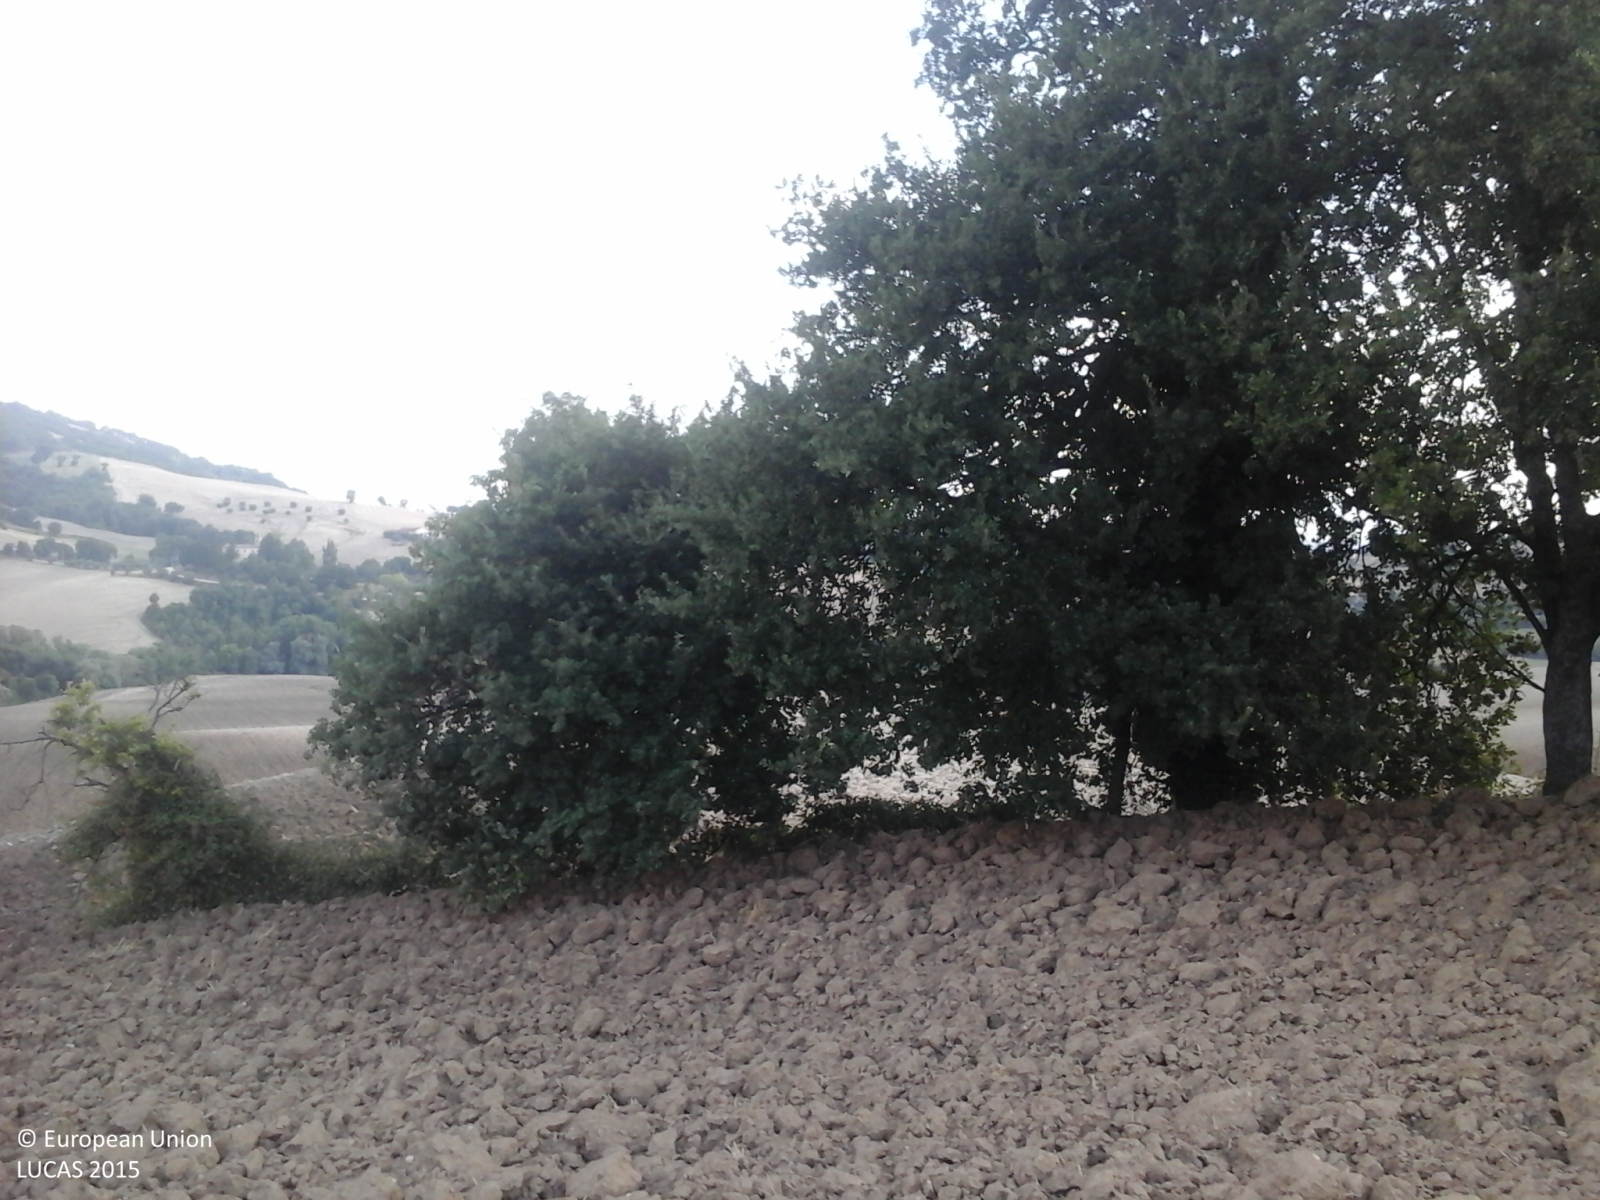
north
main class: Cropland
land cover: Common wheat
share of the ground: < 10 %
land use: Agriculture (excluding fallow land and kitchen gardens)
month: August
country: IT
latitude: 43.6621
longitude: 12.8328
